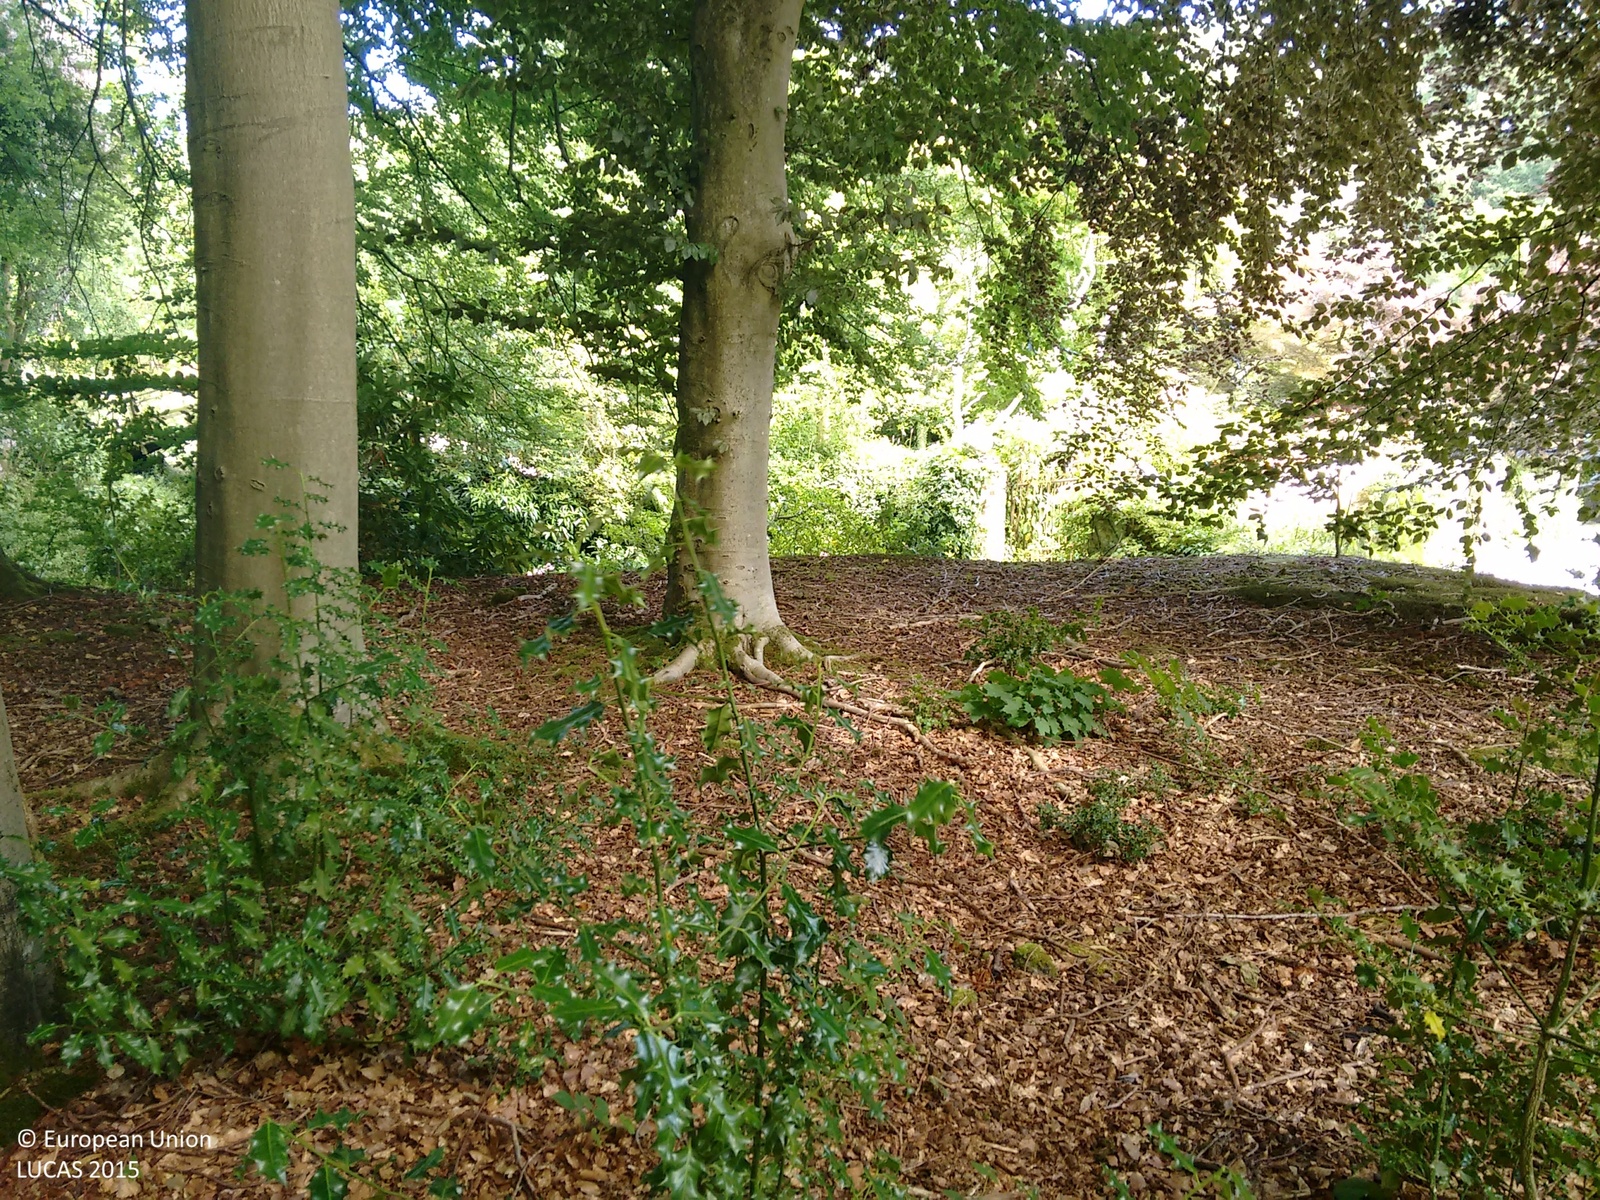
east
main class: Woodland
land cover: Broadleaved woodland
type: beech forest
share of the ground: > 75 %
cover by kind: broadleaved forest trees 100 %
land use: Residential
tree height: > 5 m
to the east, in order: Broadleaved woodland; Artificial constructions in urban areas; Inland fresh running water; Broadleaved woodland; Spontaneously vegetated surfaces; Common wheat
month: July
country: GB
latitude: 50.9836
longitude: -0.9119
